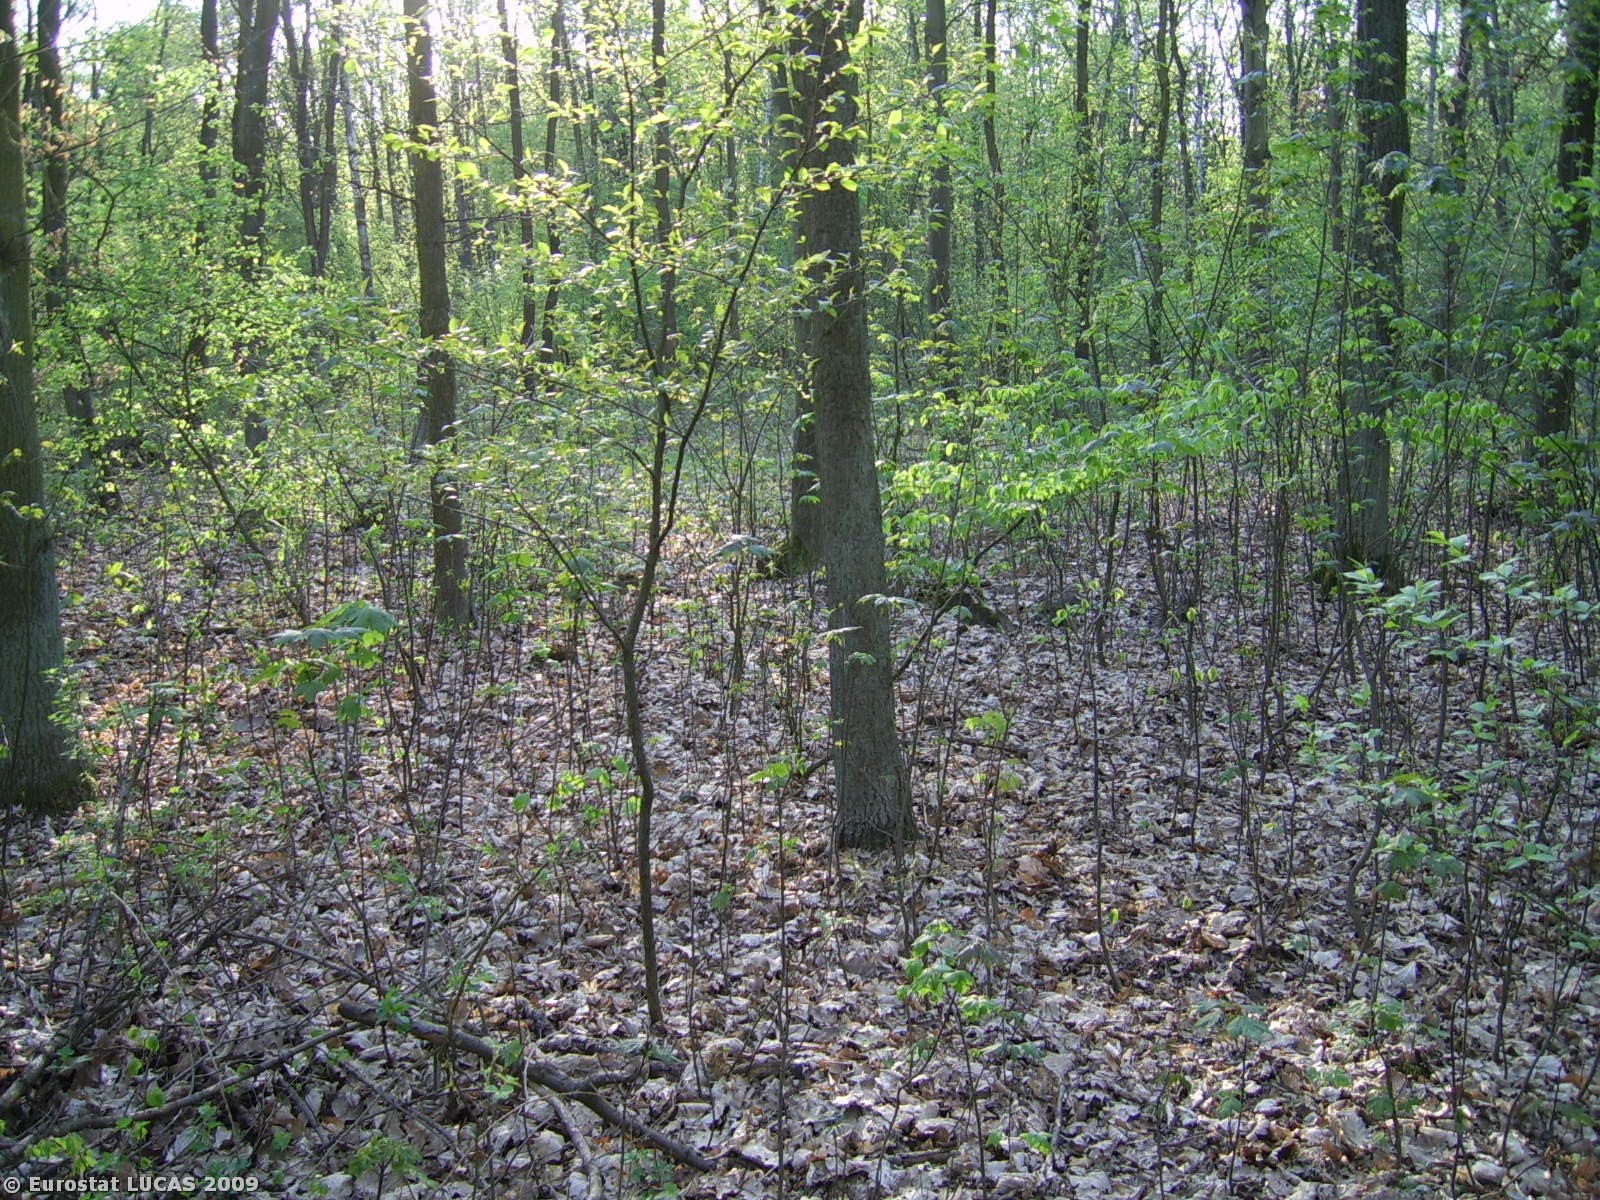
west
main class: Woodland
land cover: Mixed woodland
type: hemiboreal forest and nemoral coniferous forest and mixed broadleaved-coniferous forest
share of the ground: > 75 %
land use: Forestry
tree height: > 5 m
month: April
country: PL
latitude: 52.2662
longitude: 16.9110
